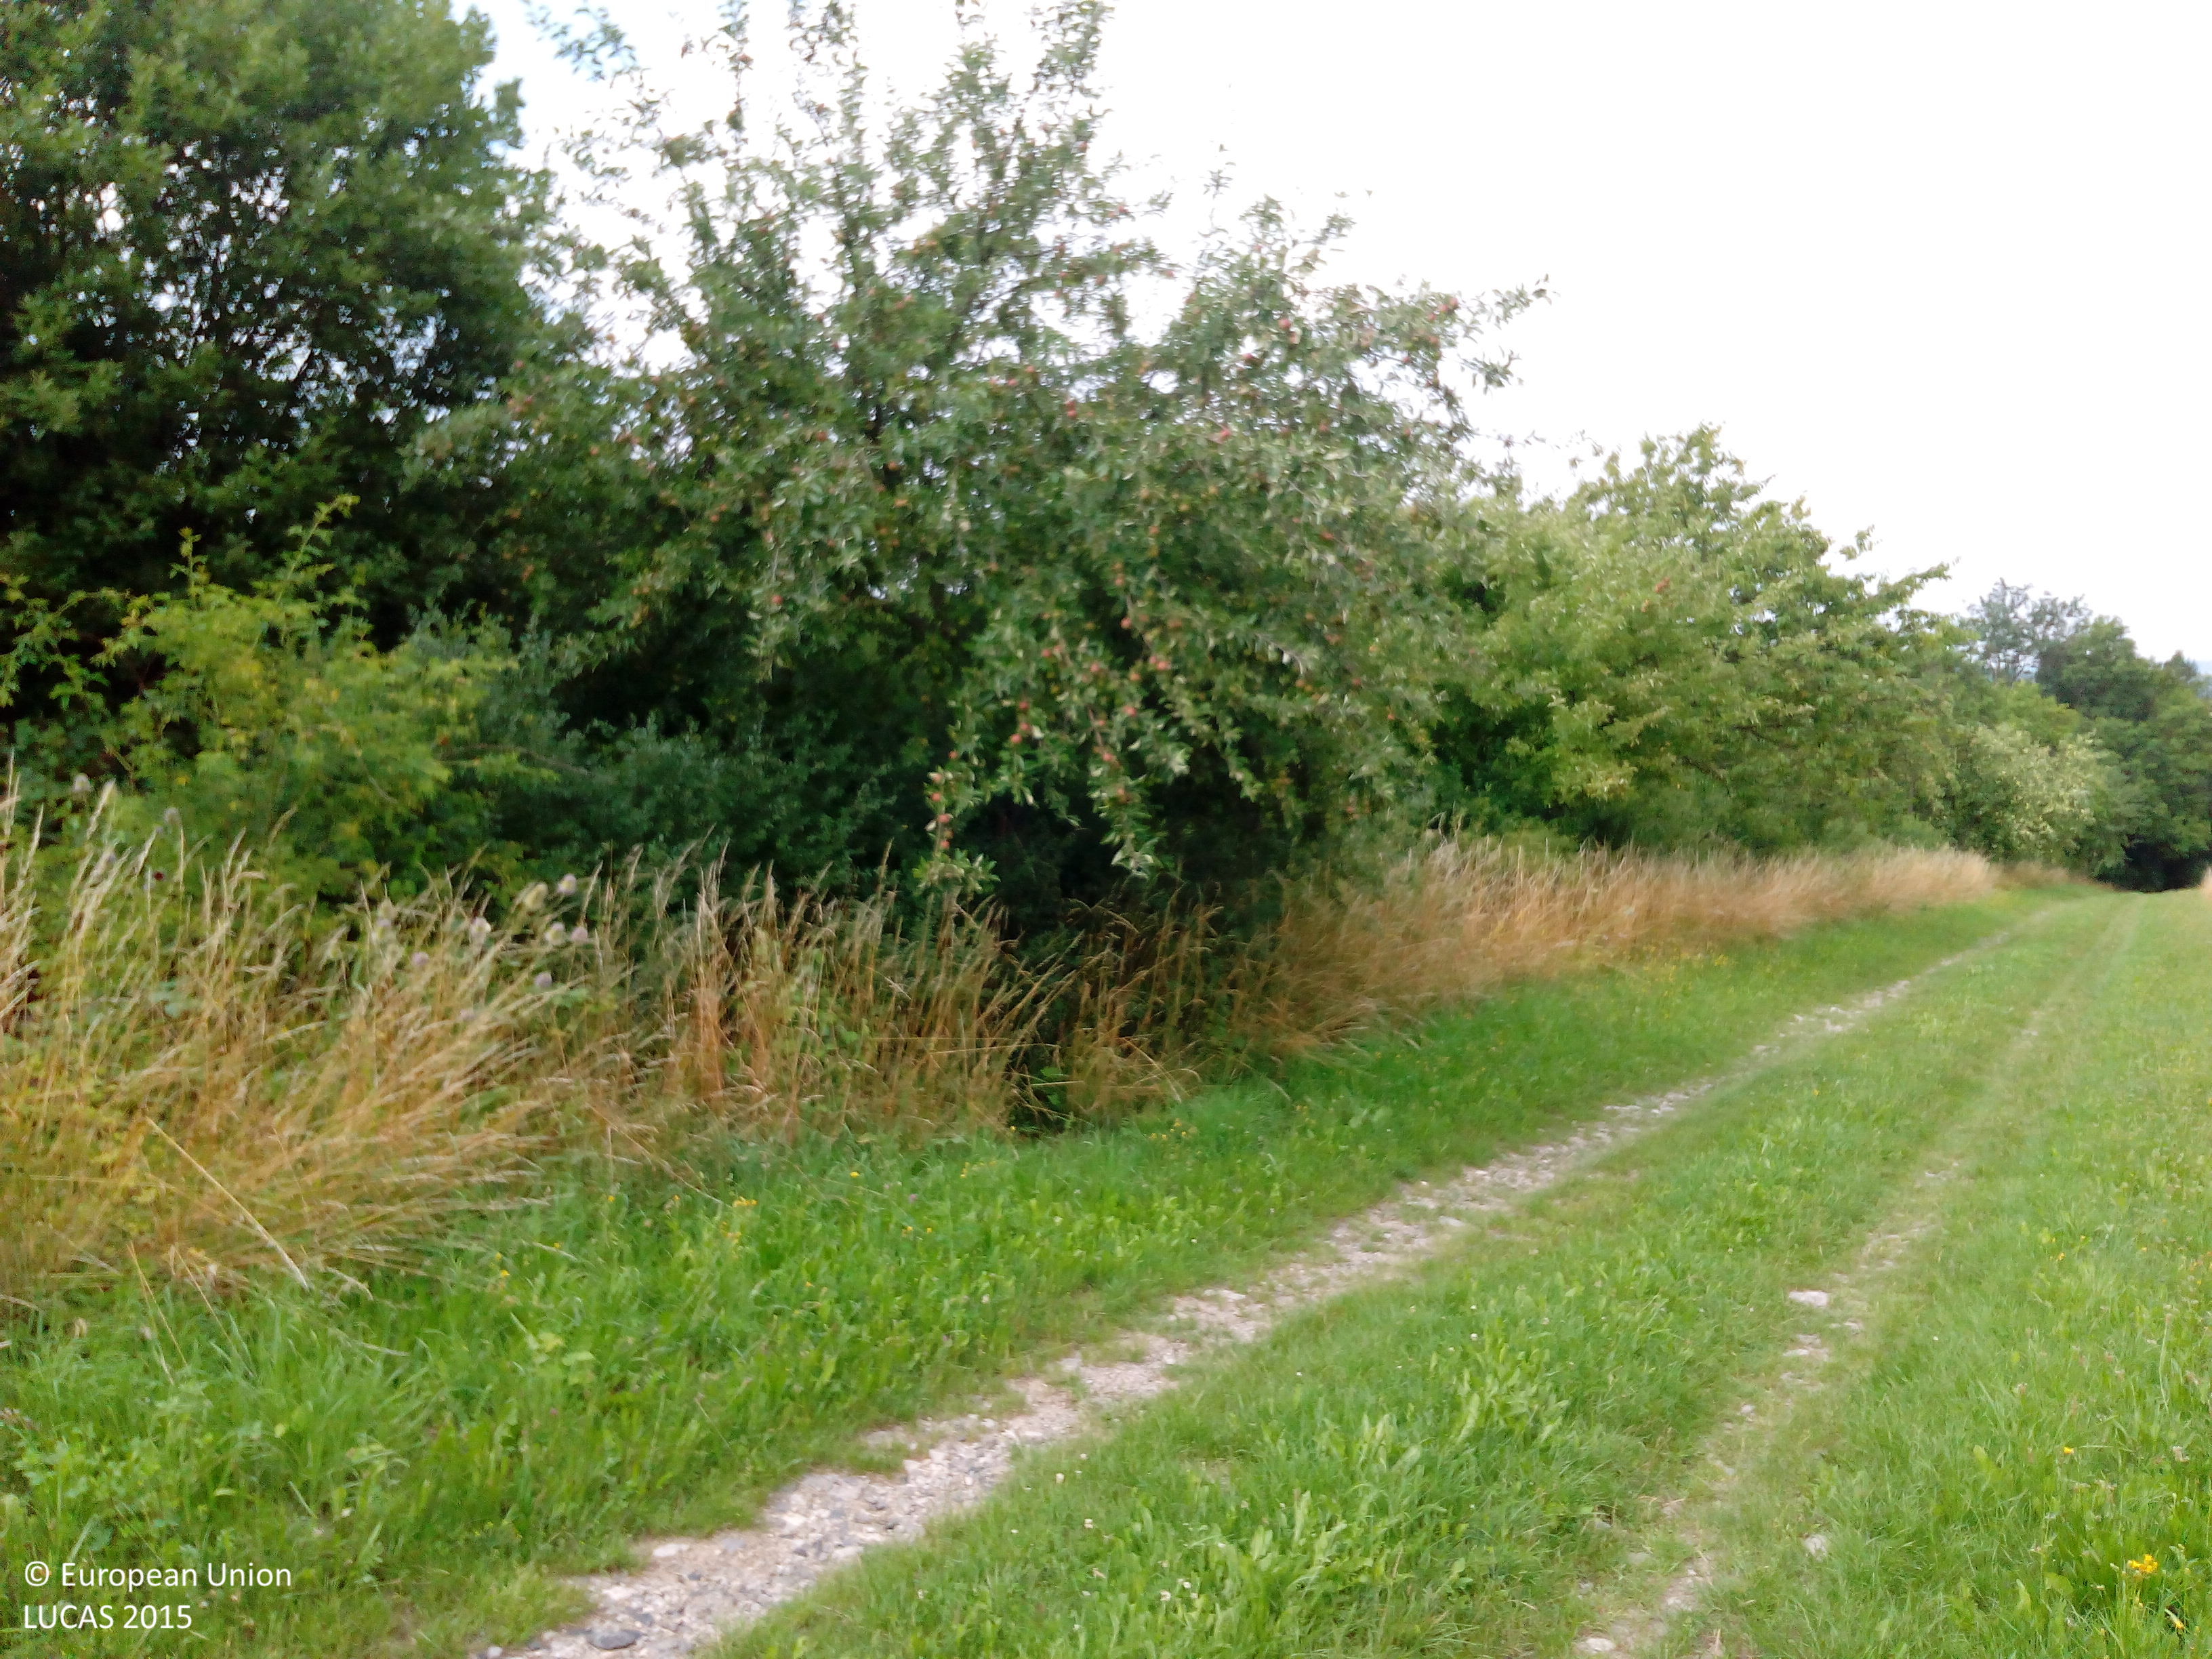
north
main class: Grassland
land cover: Grassland without tree/shrub cover
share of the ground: > 75 %
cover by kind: herbaceous plants 100 %
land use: Agriculture (excluding fallow land and kitchen gardens)
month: July
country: DE
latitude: 51.4247
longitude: 9.8706
